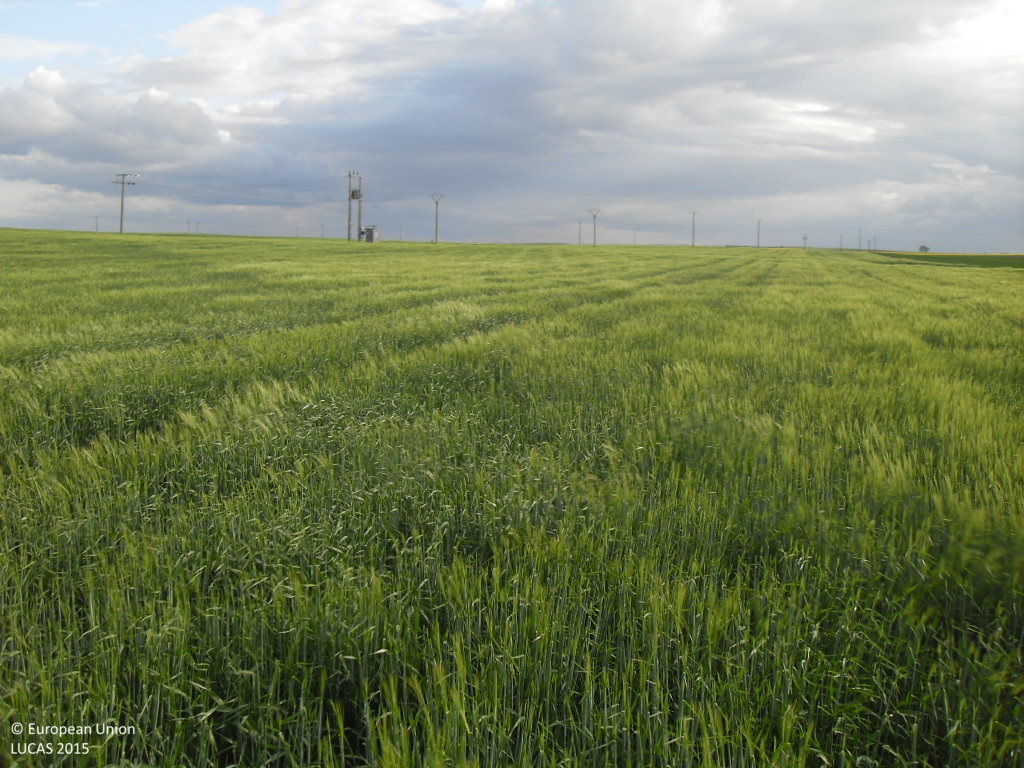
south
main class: Cropland
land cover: Barley
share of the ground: > 75 %
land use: Agriculture (excluding fallow land and kitchen gardens)
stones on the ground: < 10 %
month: April
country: ES
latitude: 41.0067
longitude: -5.1805
